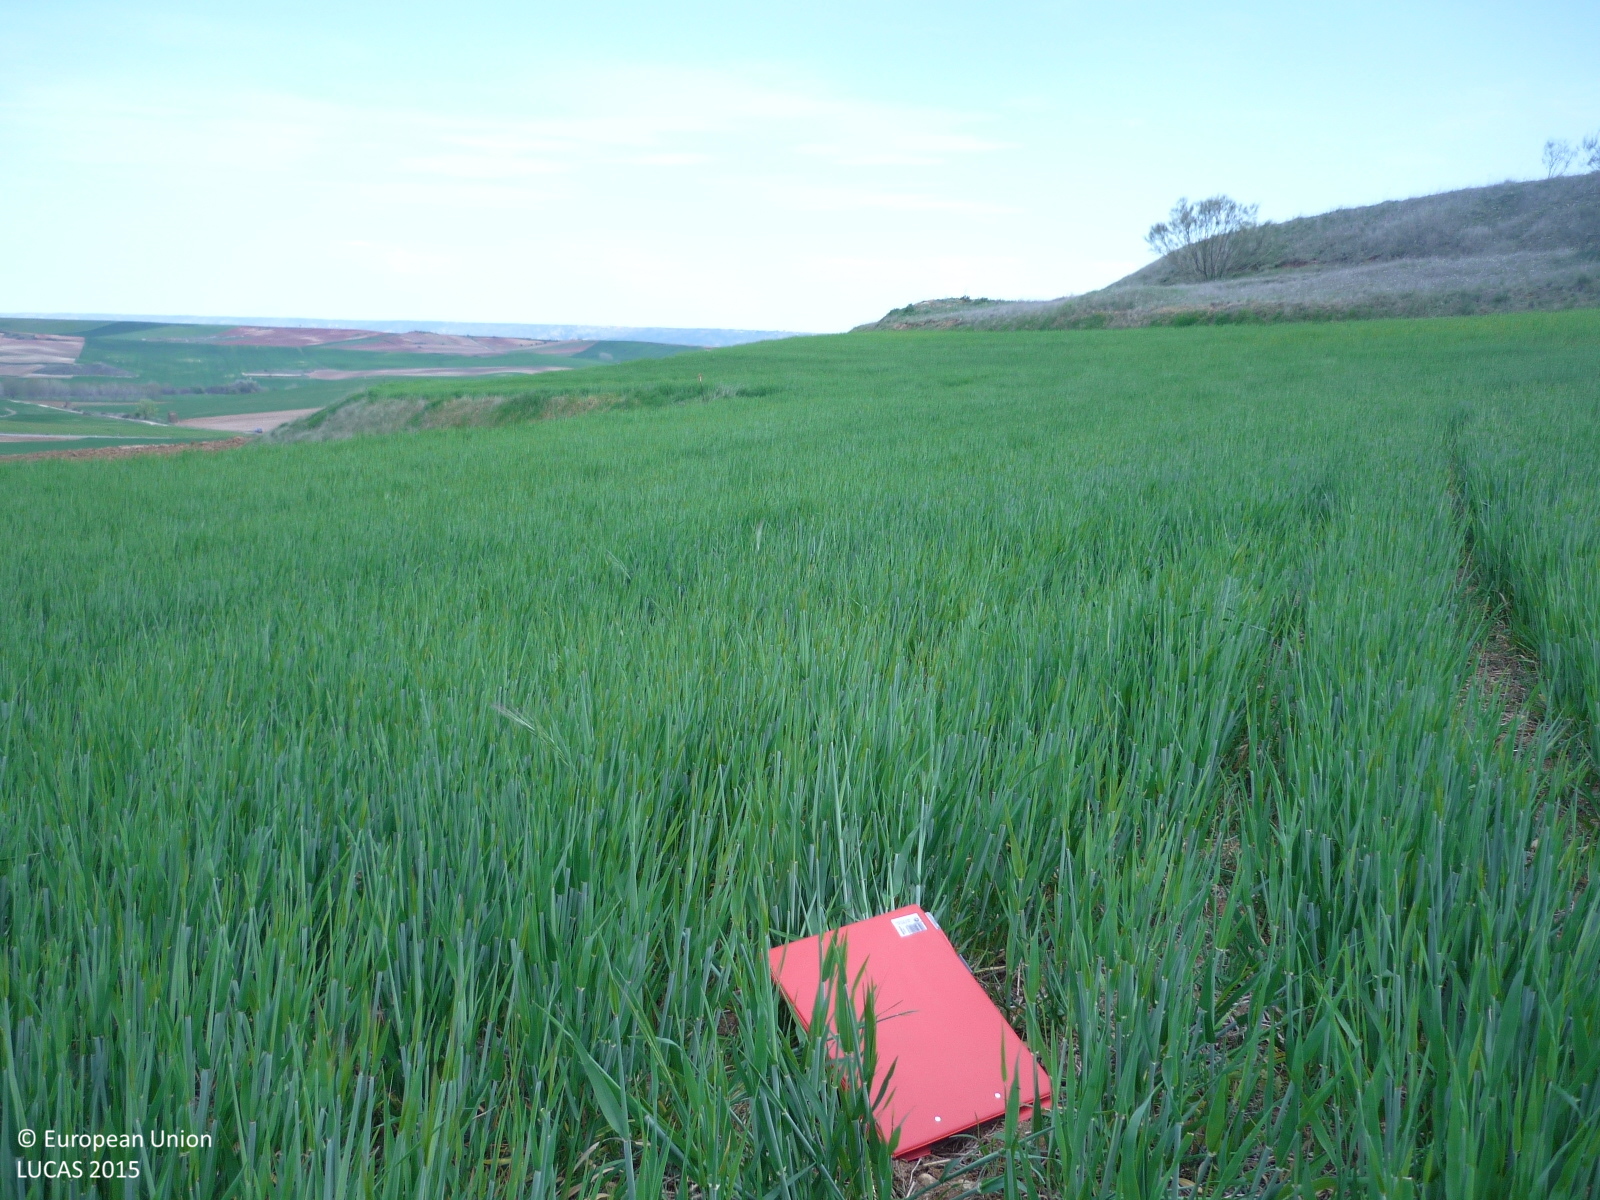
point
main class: Cropland
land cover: Barley
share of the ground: > 75 %
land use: Agriculture (excluding fallow land and kitchen gardens)
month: April
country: ES
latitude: 40.5645
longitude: -3.4416
